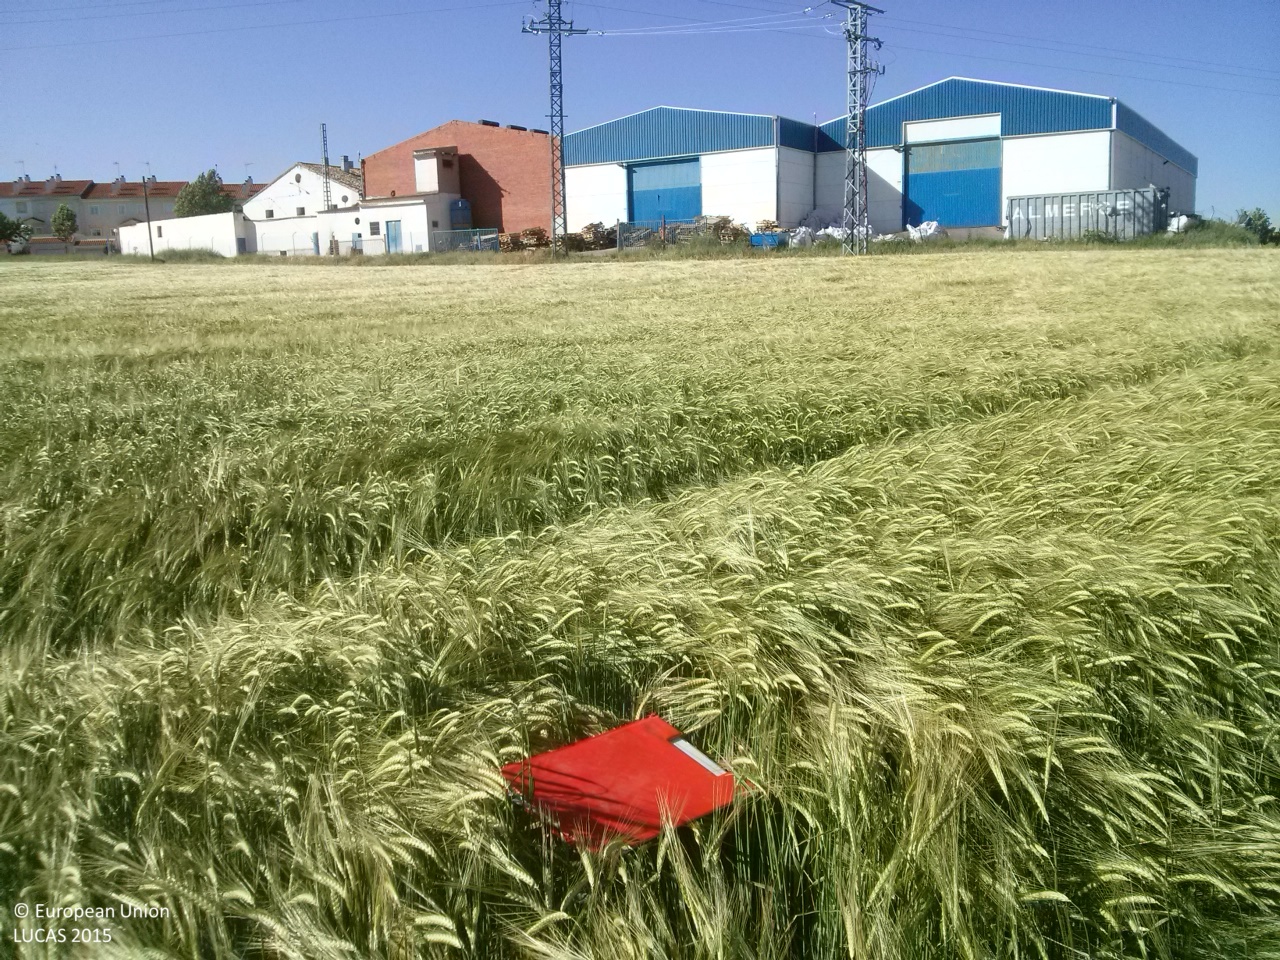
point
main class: Cropland
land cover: Barley
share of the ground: > 75 %
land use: Agriculture (excluding fallow land and kitchen gardens)
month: May
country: ES
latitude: 40.0637
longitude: -2.8134
